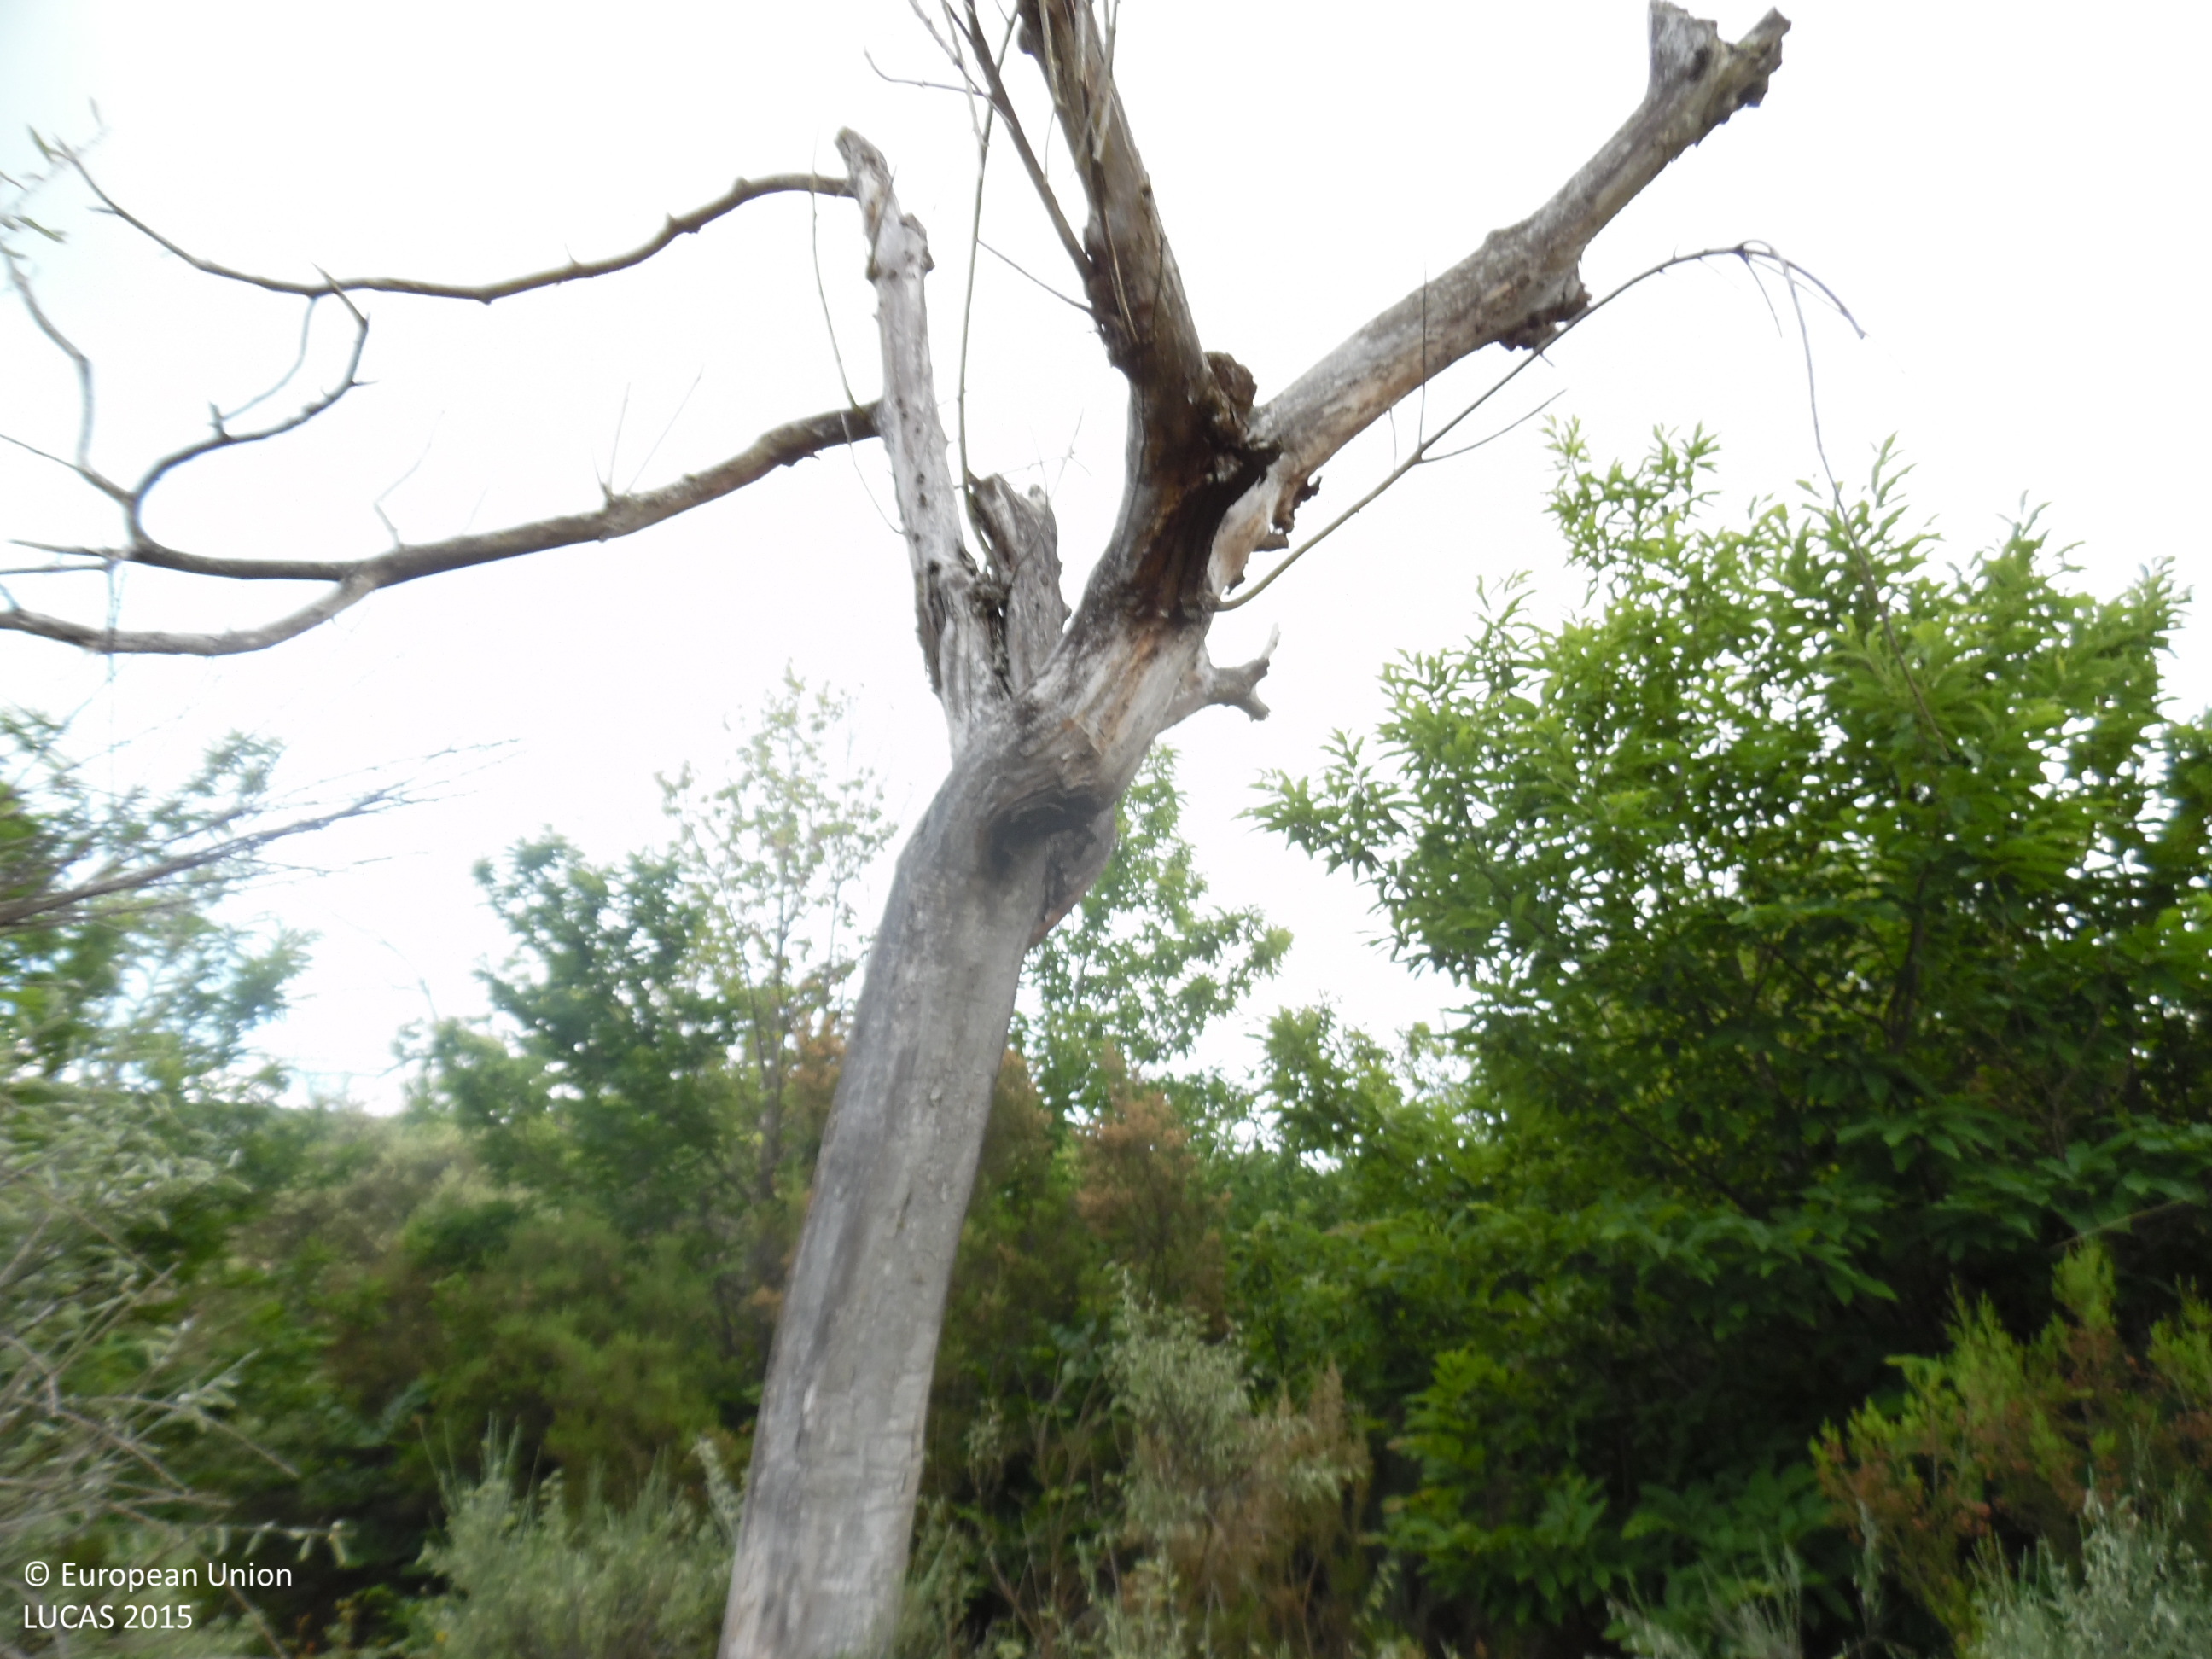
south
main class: Woodland
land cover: Broadleaved woodland
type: thermophilous deciduous forest
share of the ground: > 75 %
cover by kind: broadleaved forest trees 90 %, shrubs 5 %, consolidated bare surface 5 %
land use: Semi-natural and natural areas not in use
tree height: > 5 m
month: June
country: ES
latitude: 42.5708
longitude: -6.4280
